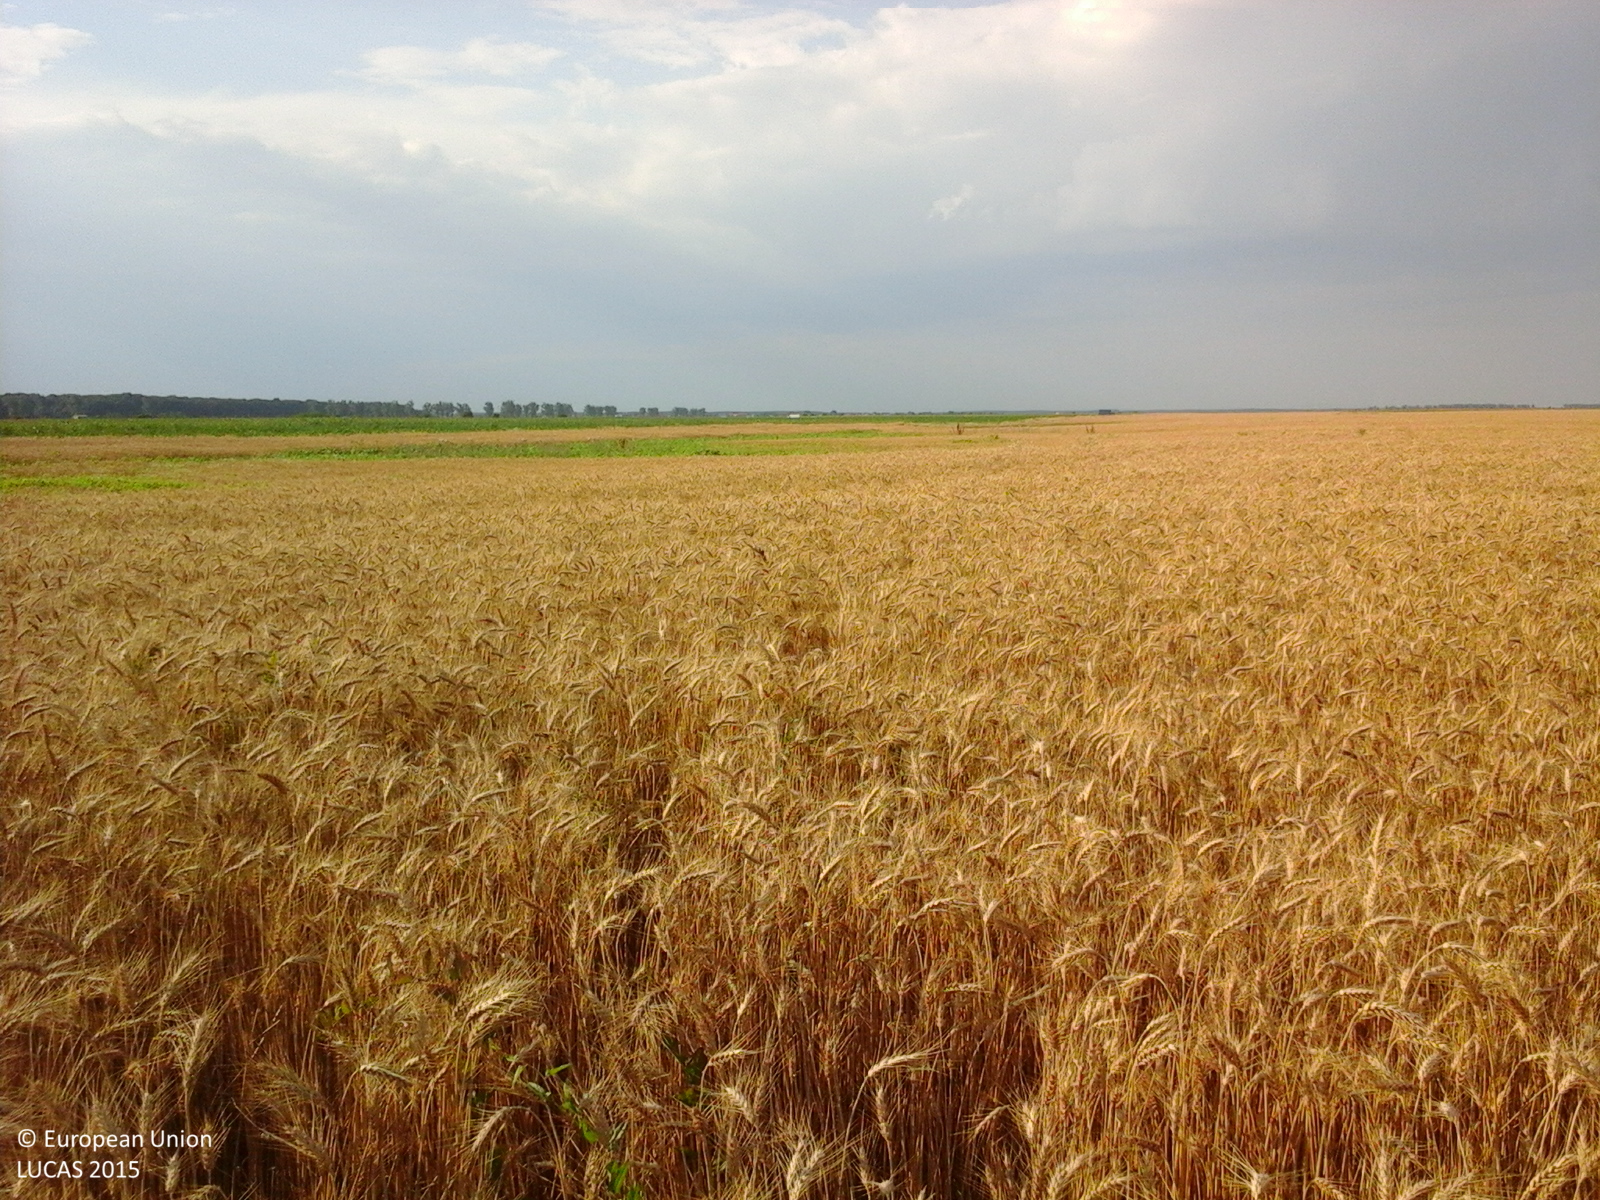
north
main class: Cropland
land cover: Common wheat
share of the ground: > 75 %
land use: Agriculture (excluding fallow land and kitchen gardens)
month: June
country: RO
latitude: 44.5671
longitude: 26.2394
